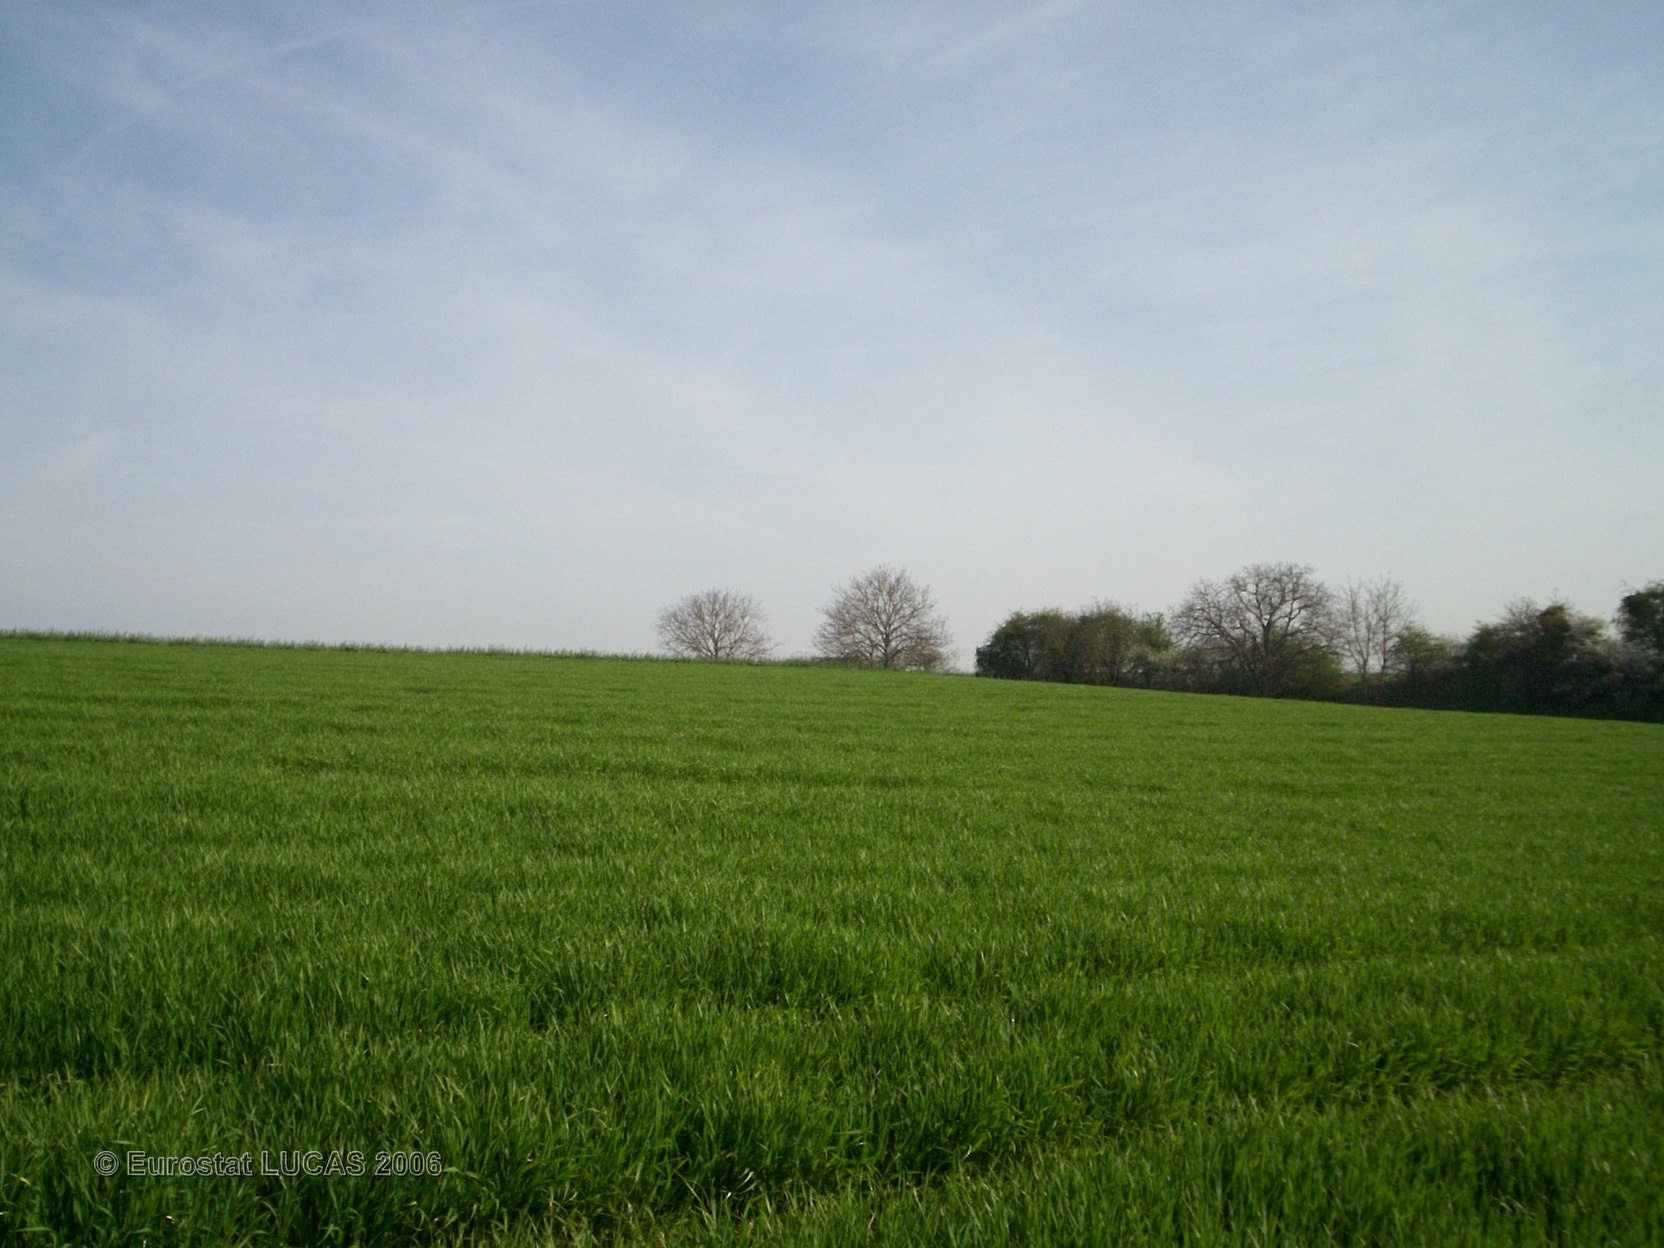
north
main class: Cropland
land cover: Barley
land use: Agriculture (excluding fallow land and kitchen gardens)
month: April
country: FR
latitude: 48.3527
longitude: 2.8528
